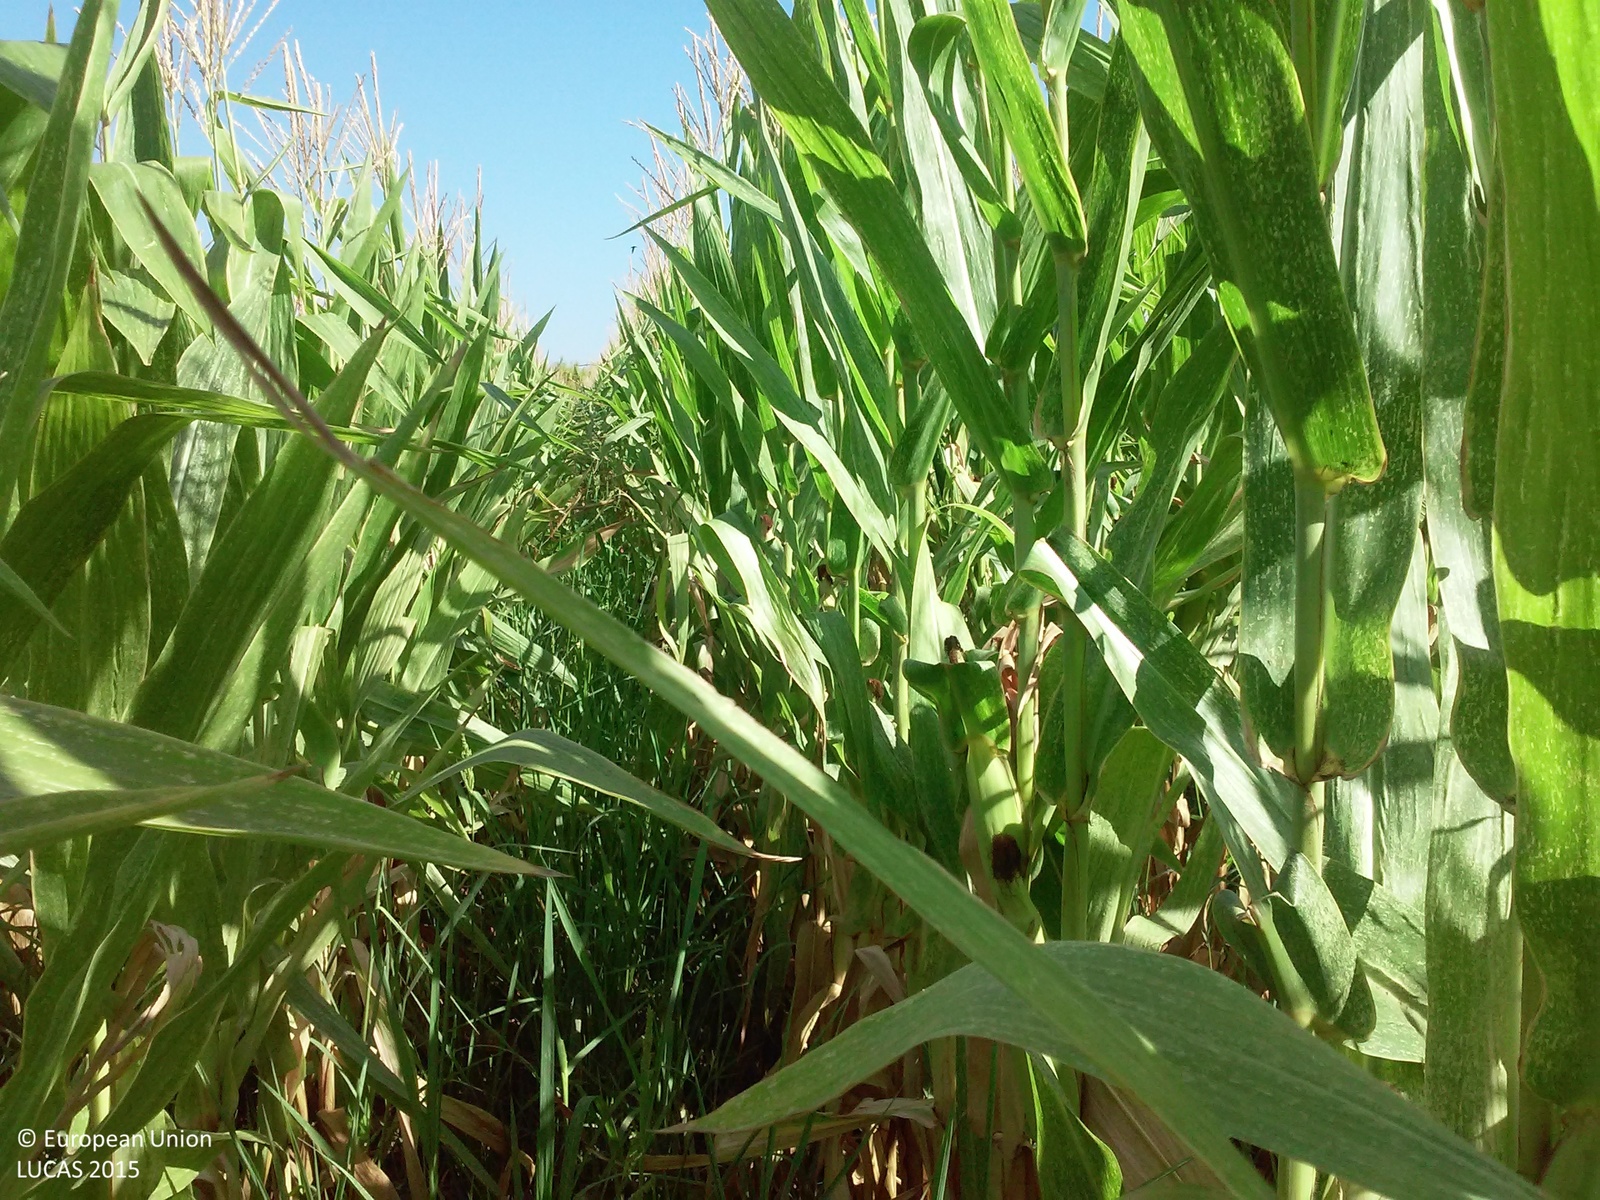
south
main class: Cropland
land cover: Maize
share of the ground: > 75 %
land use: Agriculture (excluding fallow land and kitchen gardens)
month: July
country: ES
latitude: 41.6960
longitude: 0.6751
